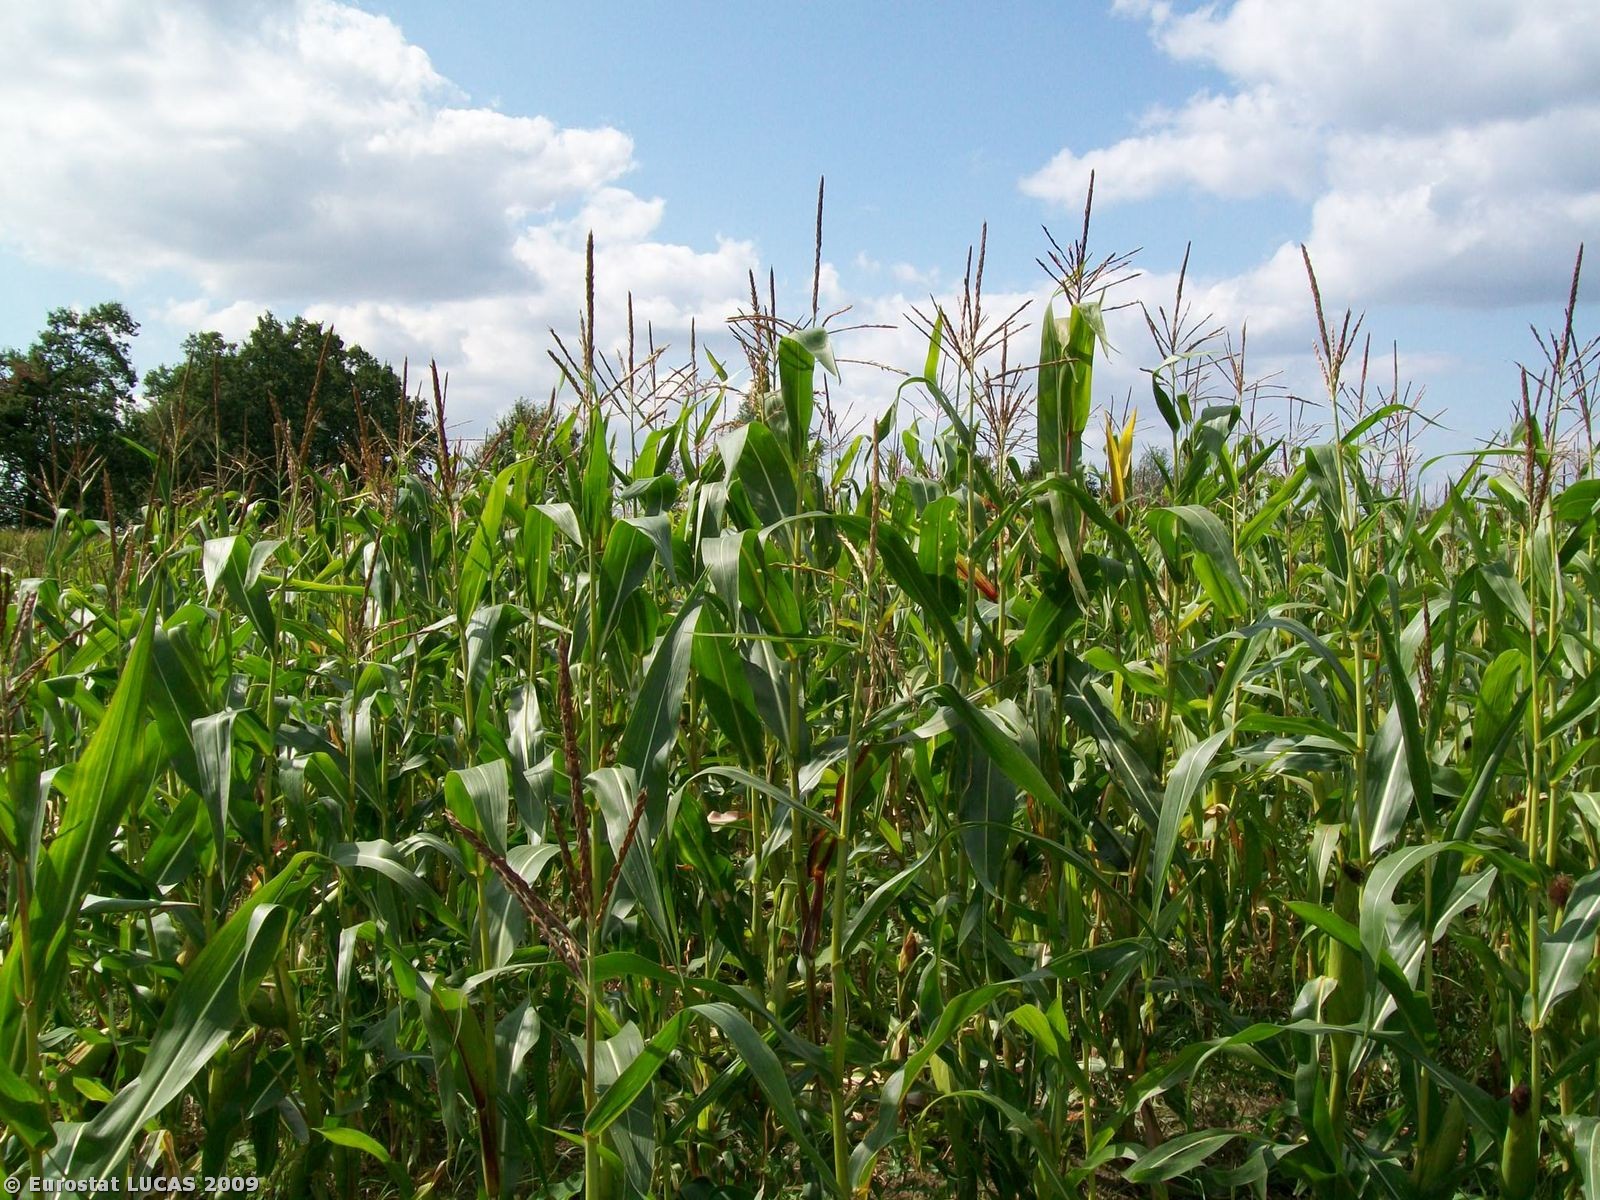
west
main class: Cropland
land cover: Maize
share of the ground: 50 - 75 %
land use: Agriculture (excluding fallow land and kitchen gardens)
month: August
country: PL
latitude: 51.0174
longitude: 17.2673
